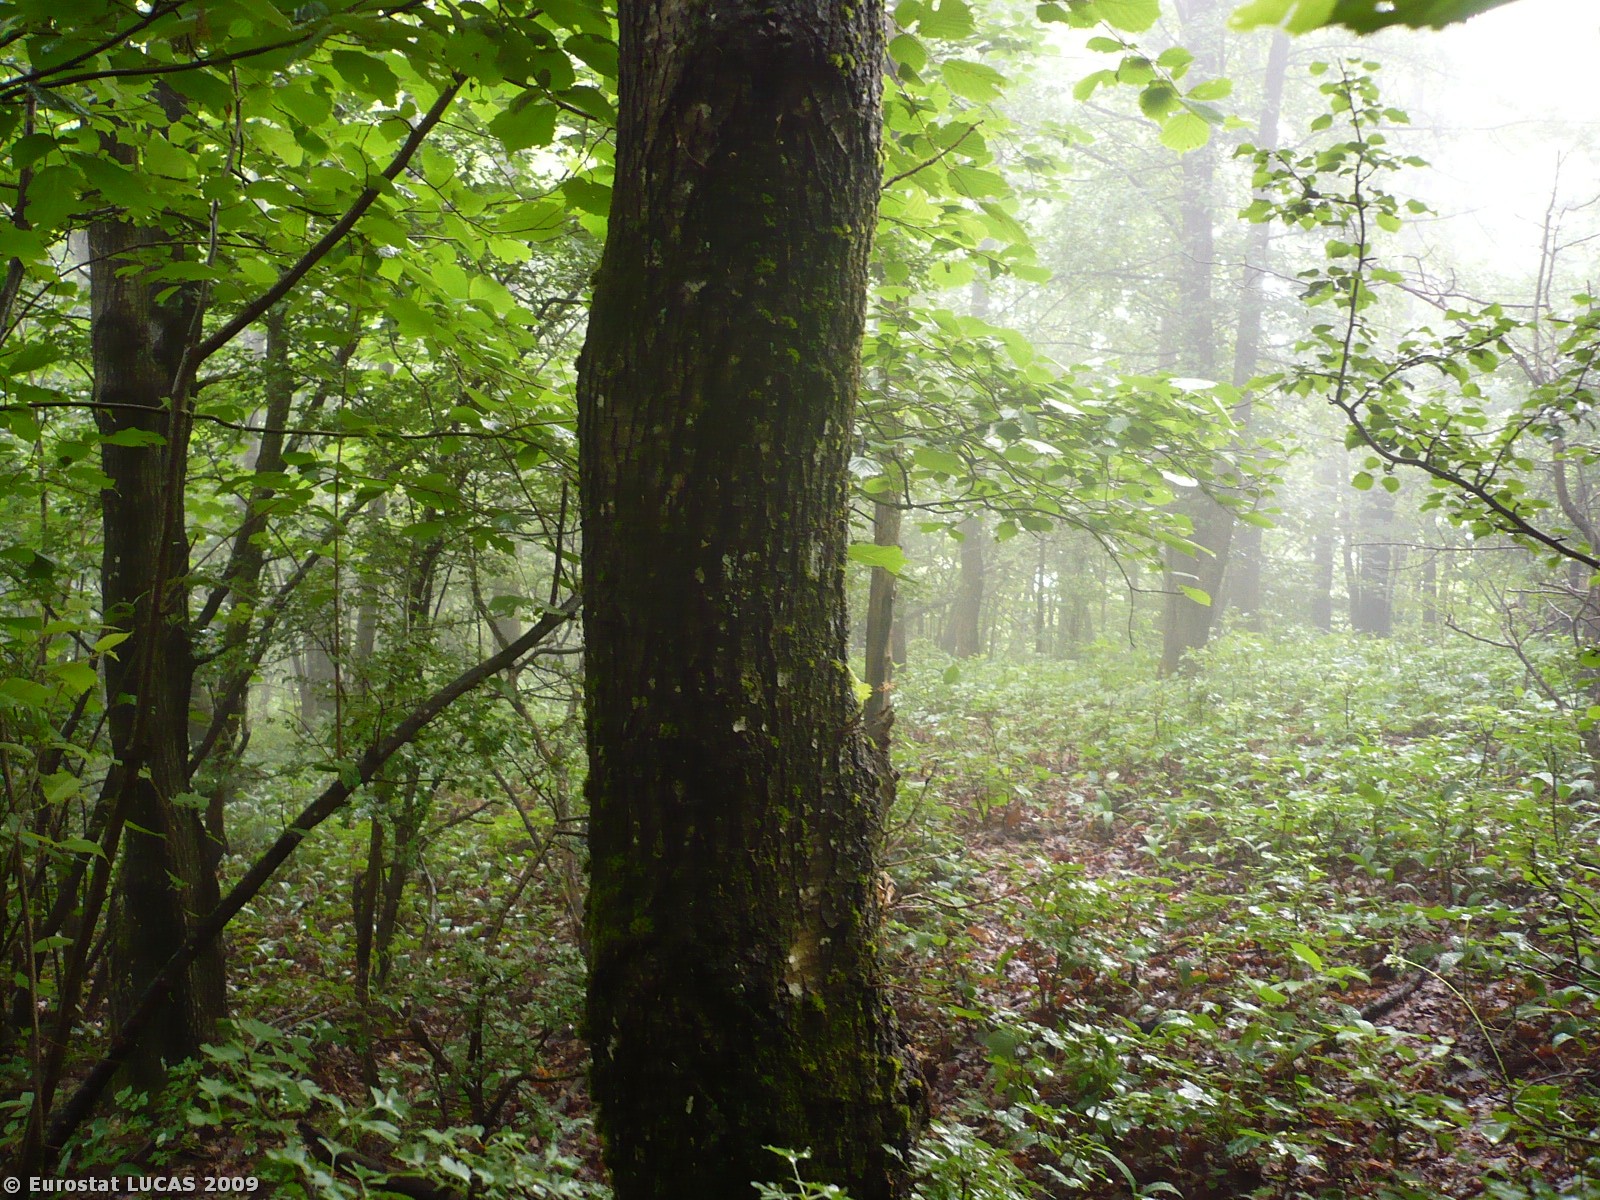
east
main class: Woodland
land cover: Broadleaved woodland
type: acidophilous oak and oak-birch forest
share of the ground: > 75 %
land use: Forestry
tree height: > 5 m
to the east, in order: Broadleaved woodland; Rivers and streams; Tracks; Broadleaved woodland
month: June
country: SI
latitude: 45.5247
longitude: 14.3101
